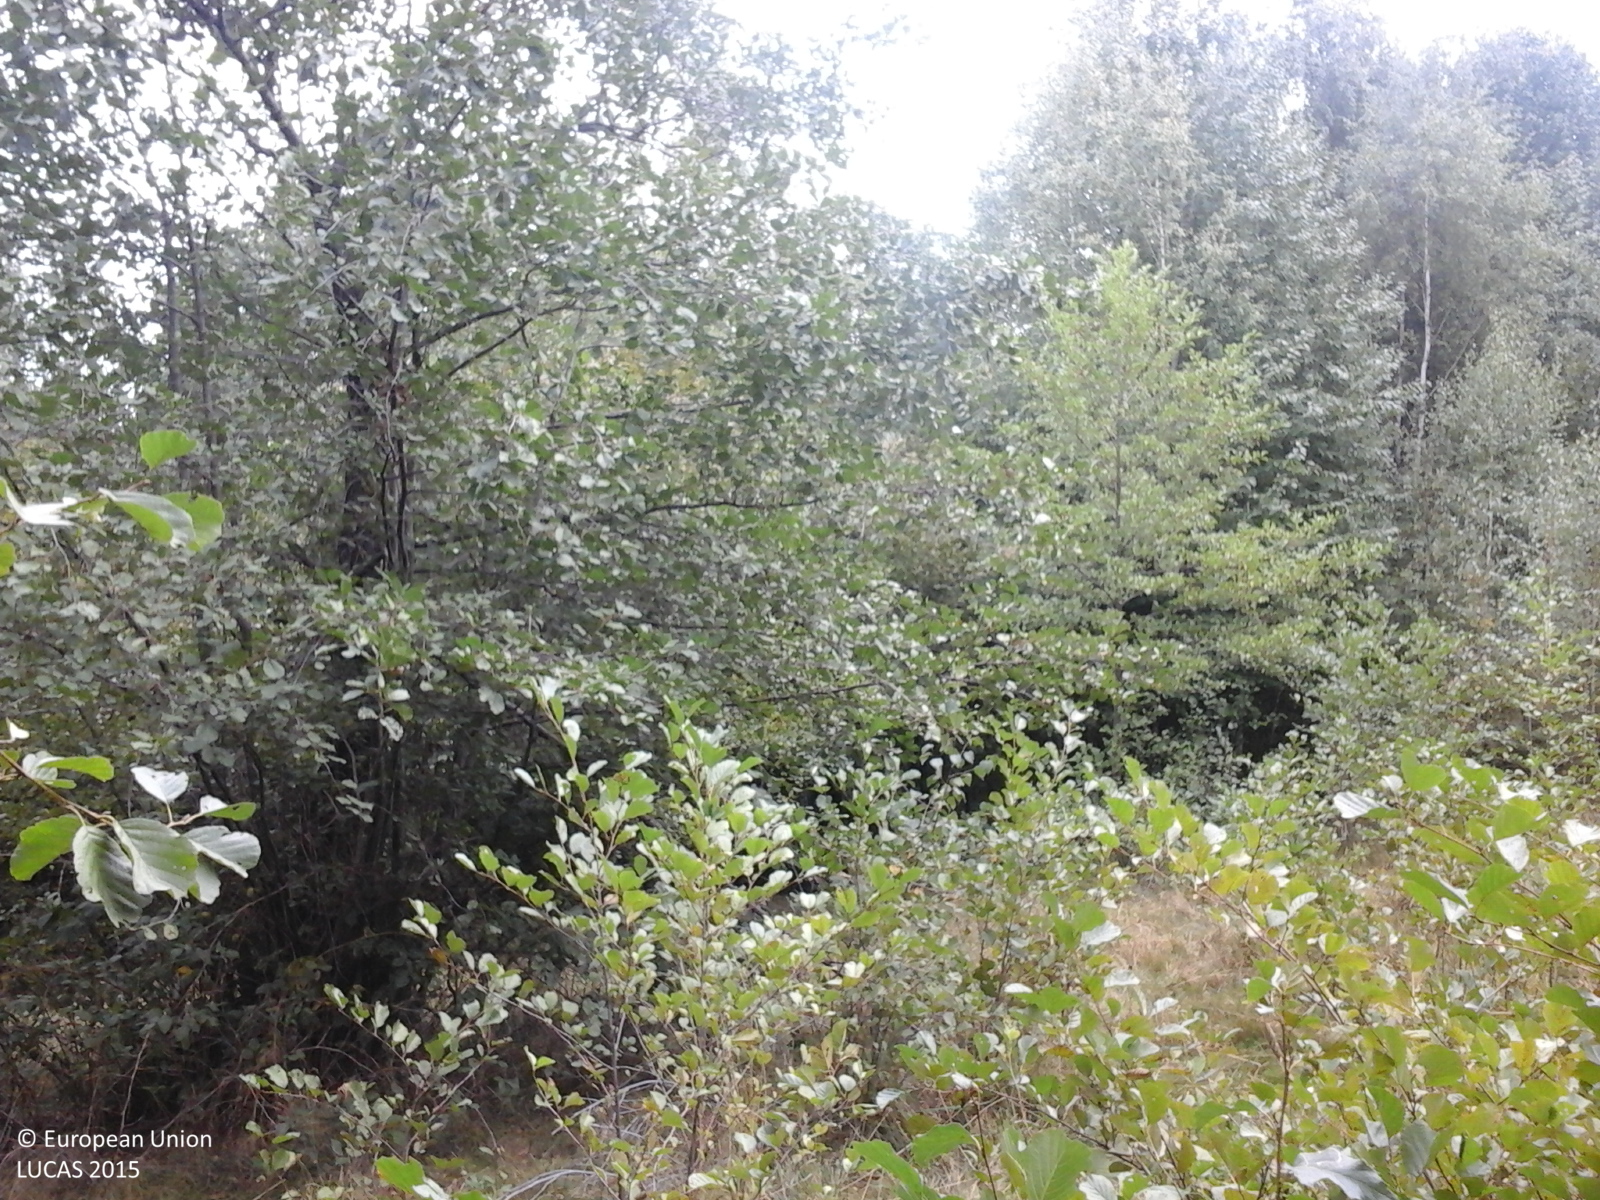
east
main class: Woodland
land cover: Broadleaved woodland
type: non-riverine alder, birch or aspen forest
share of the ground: > 75 %
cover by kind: broadleaved forest trees 100 %
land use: Forestry
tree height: > 5 m
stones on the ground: < 10 %
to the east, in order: Broadleaved woodland; Grassland with sparse tree/shrub cover; Broadleaved woodland; Grassland without tree/shrub cover; Broadleaved woodland
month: September
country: RO
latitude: 45.4573
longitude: 23.1888
